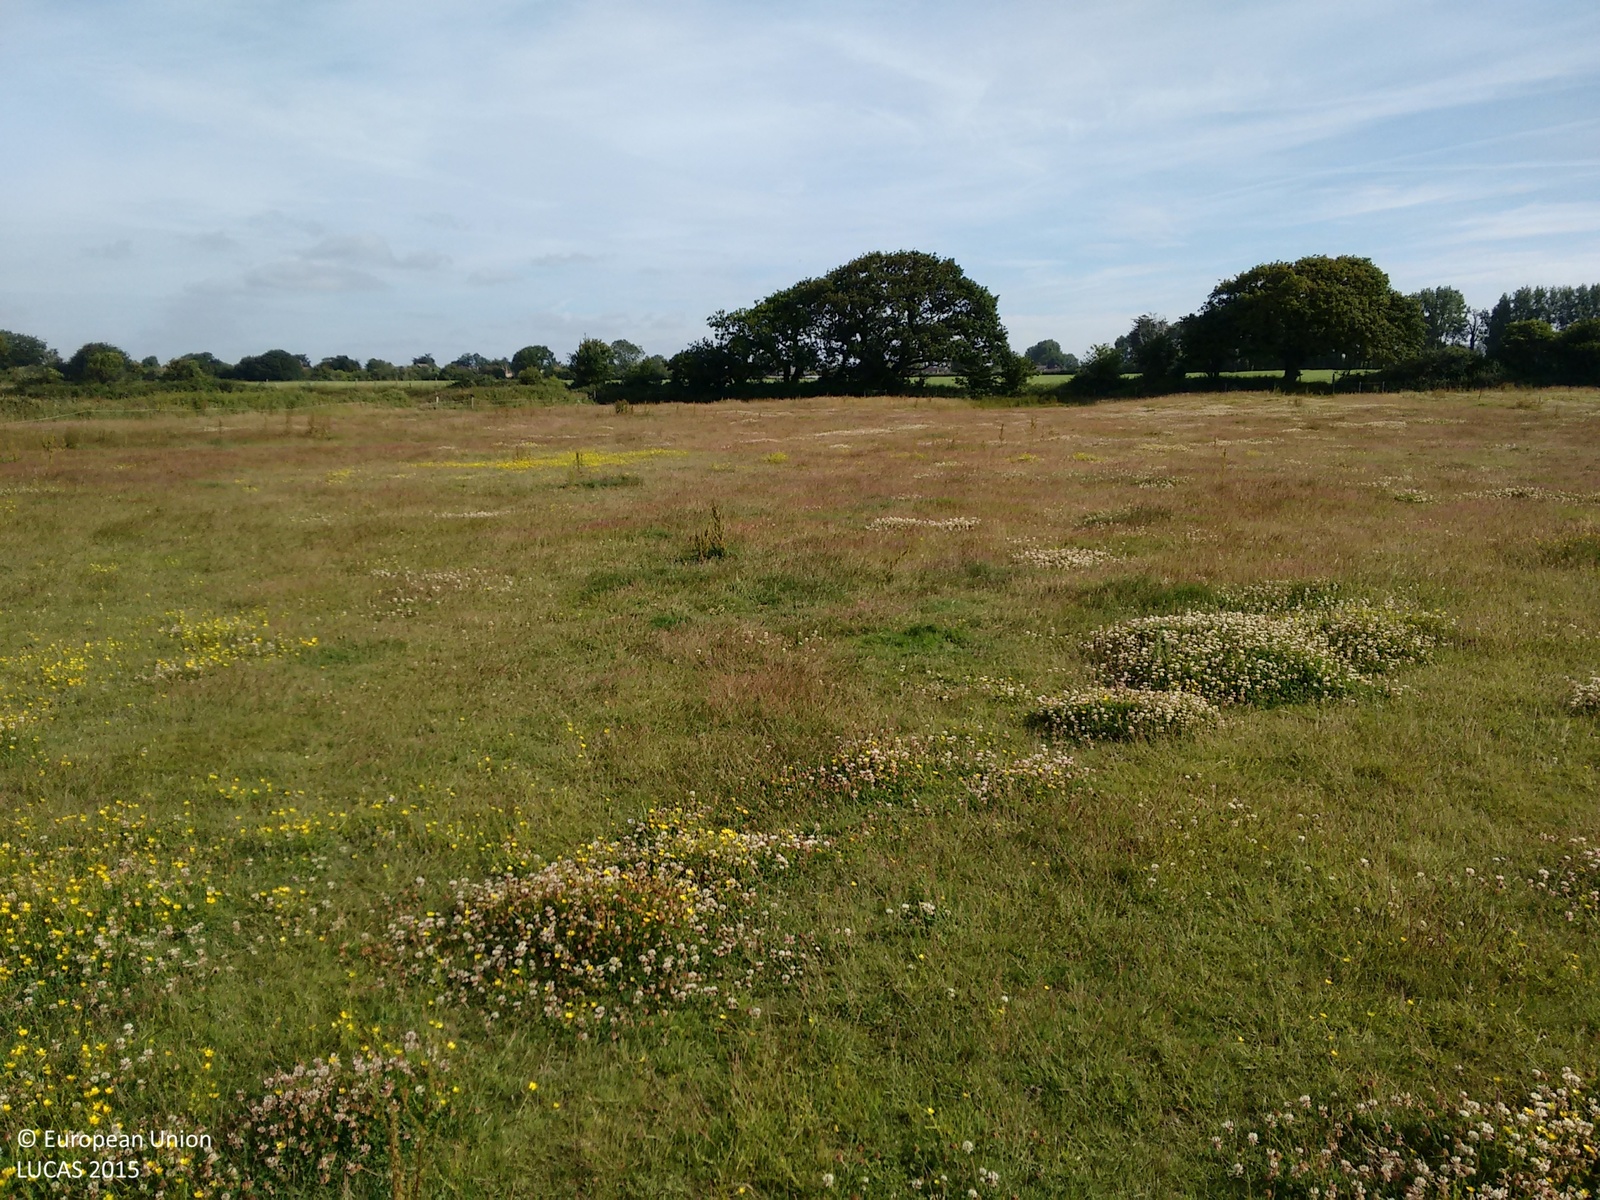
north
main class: Grassland
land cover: Grassland without tree/shrub cover
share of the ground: > 75 %
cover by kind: herbaceous plants 100 %
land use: Agriculture (excluding fallow land and kitchen gardens)
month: June
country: GB
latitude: 50.8389
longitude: -0.9065
